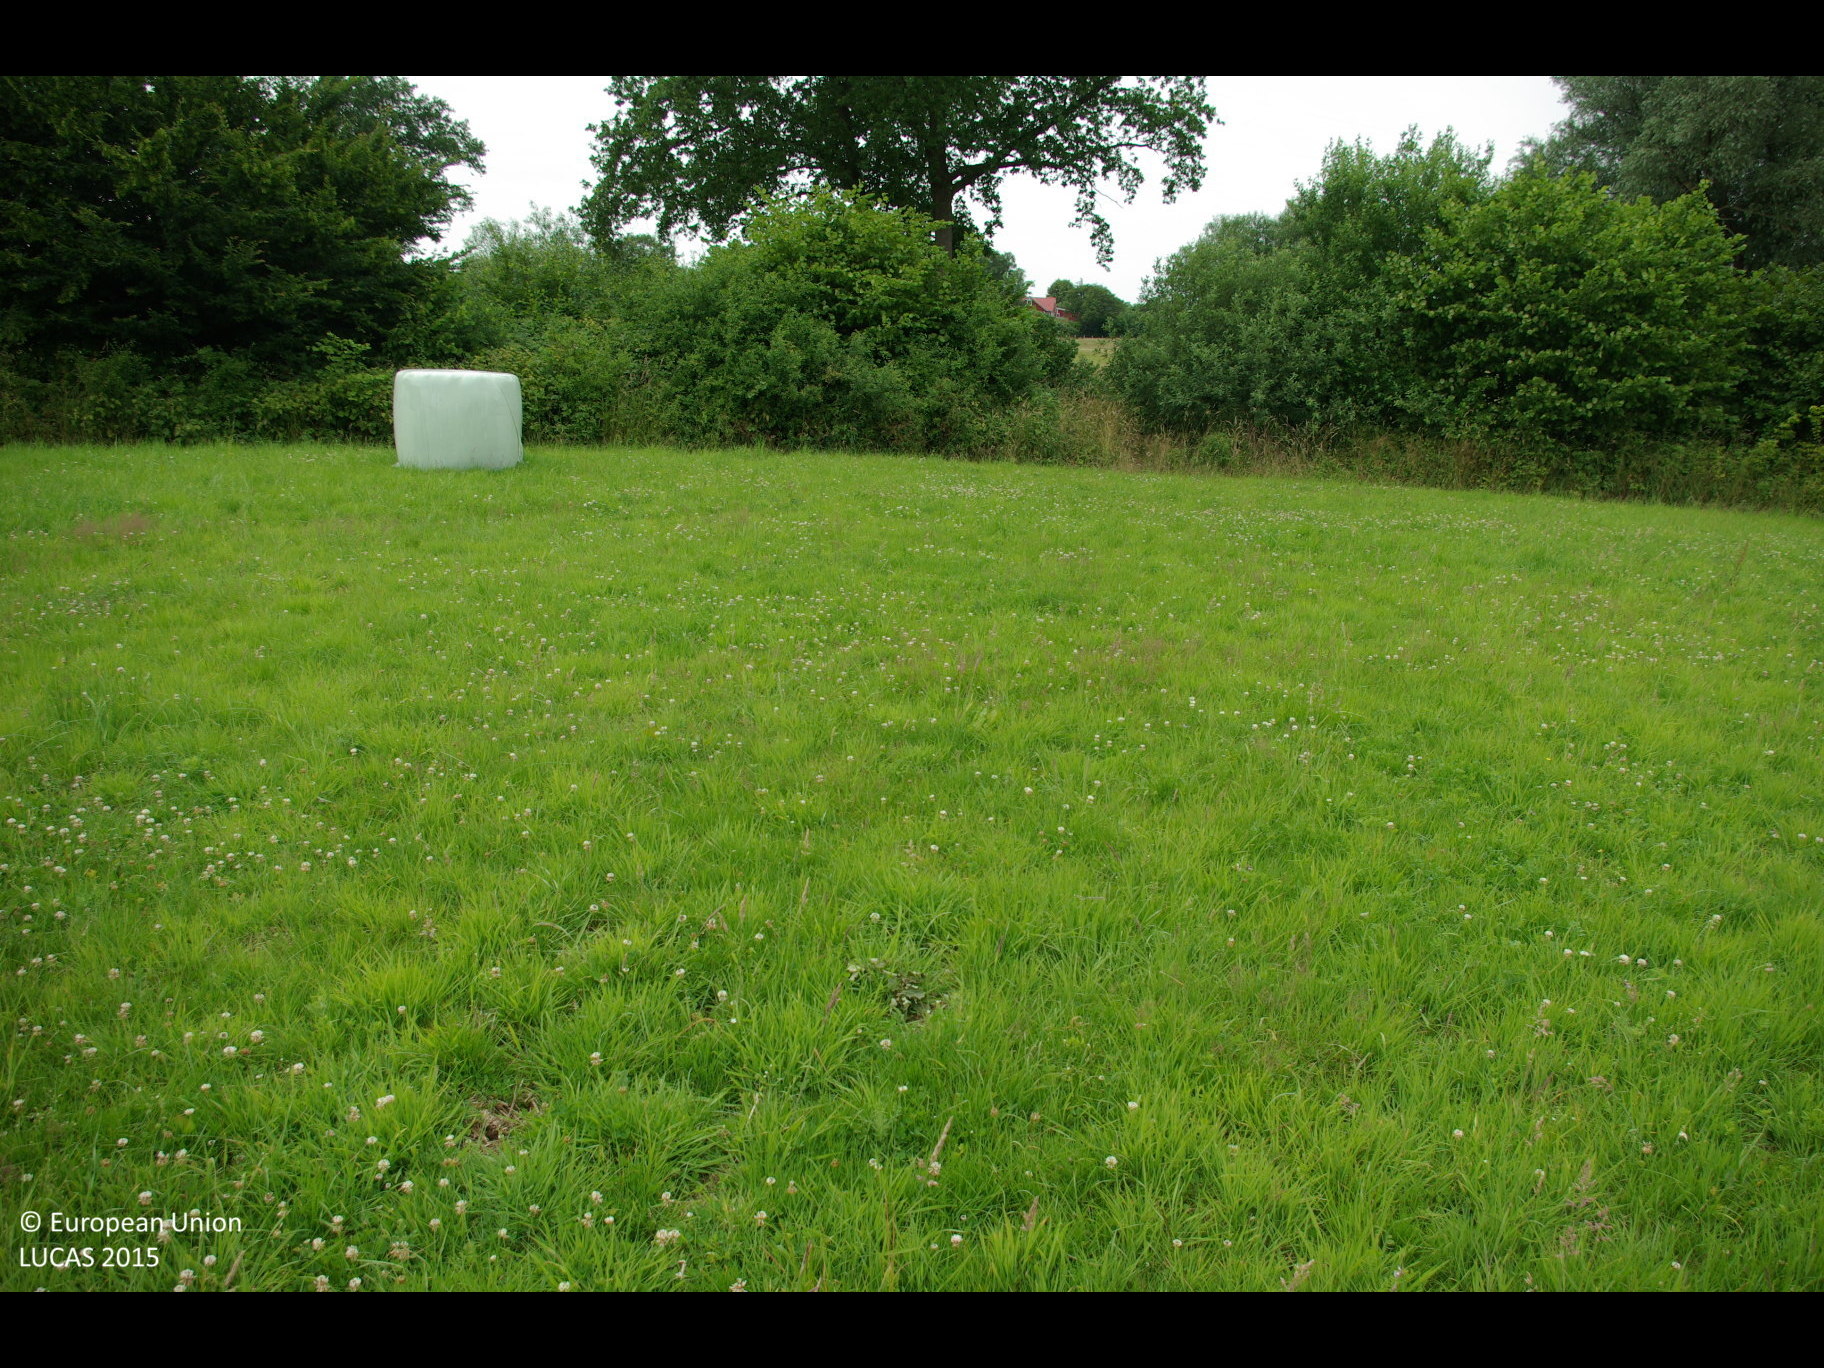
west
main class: Grassland
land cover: Grassland without tree/shrub cover
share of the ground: > 75 %
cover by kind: herbaceous plants 100 %
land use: Agriculture (excluding fallow land and kitchen gardens)
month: July
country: DE
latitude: 54.1192
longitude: 10.6269
